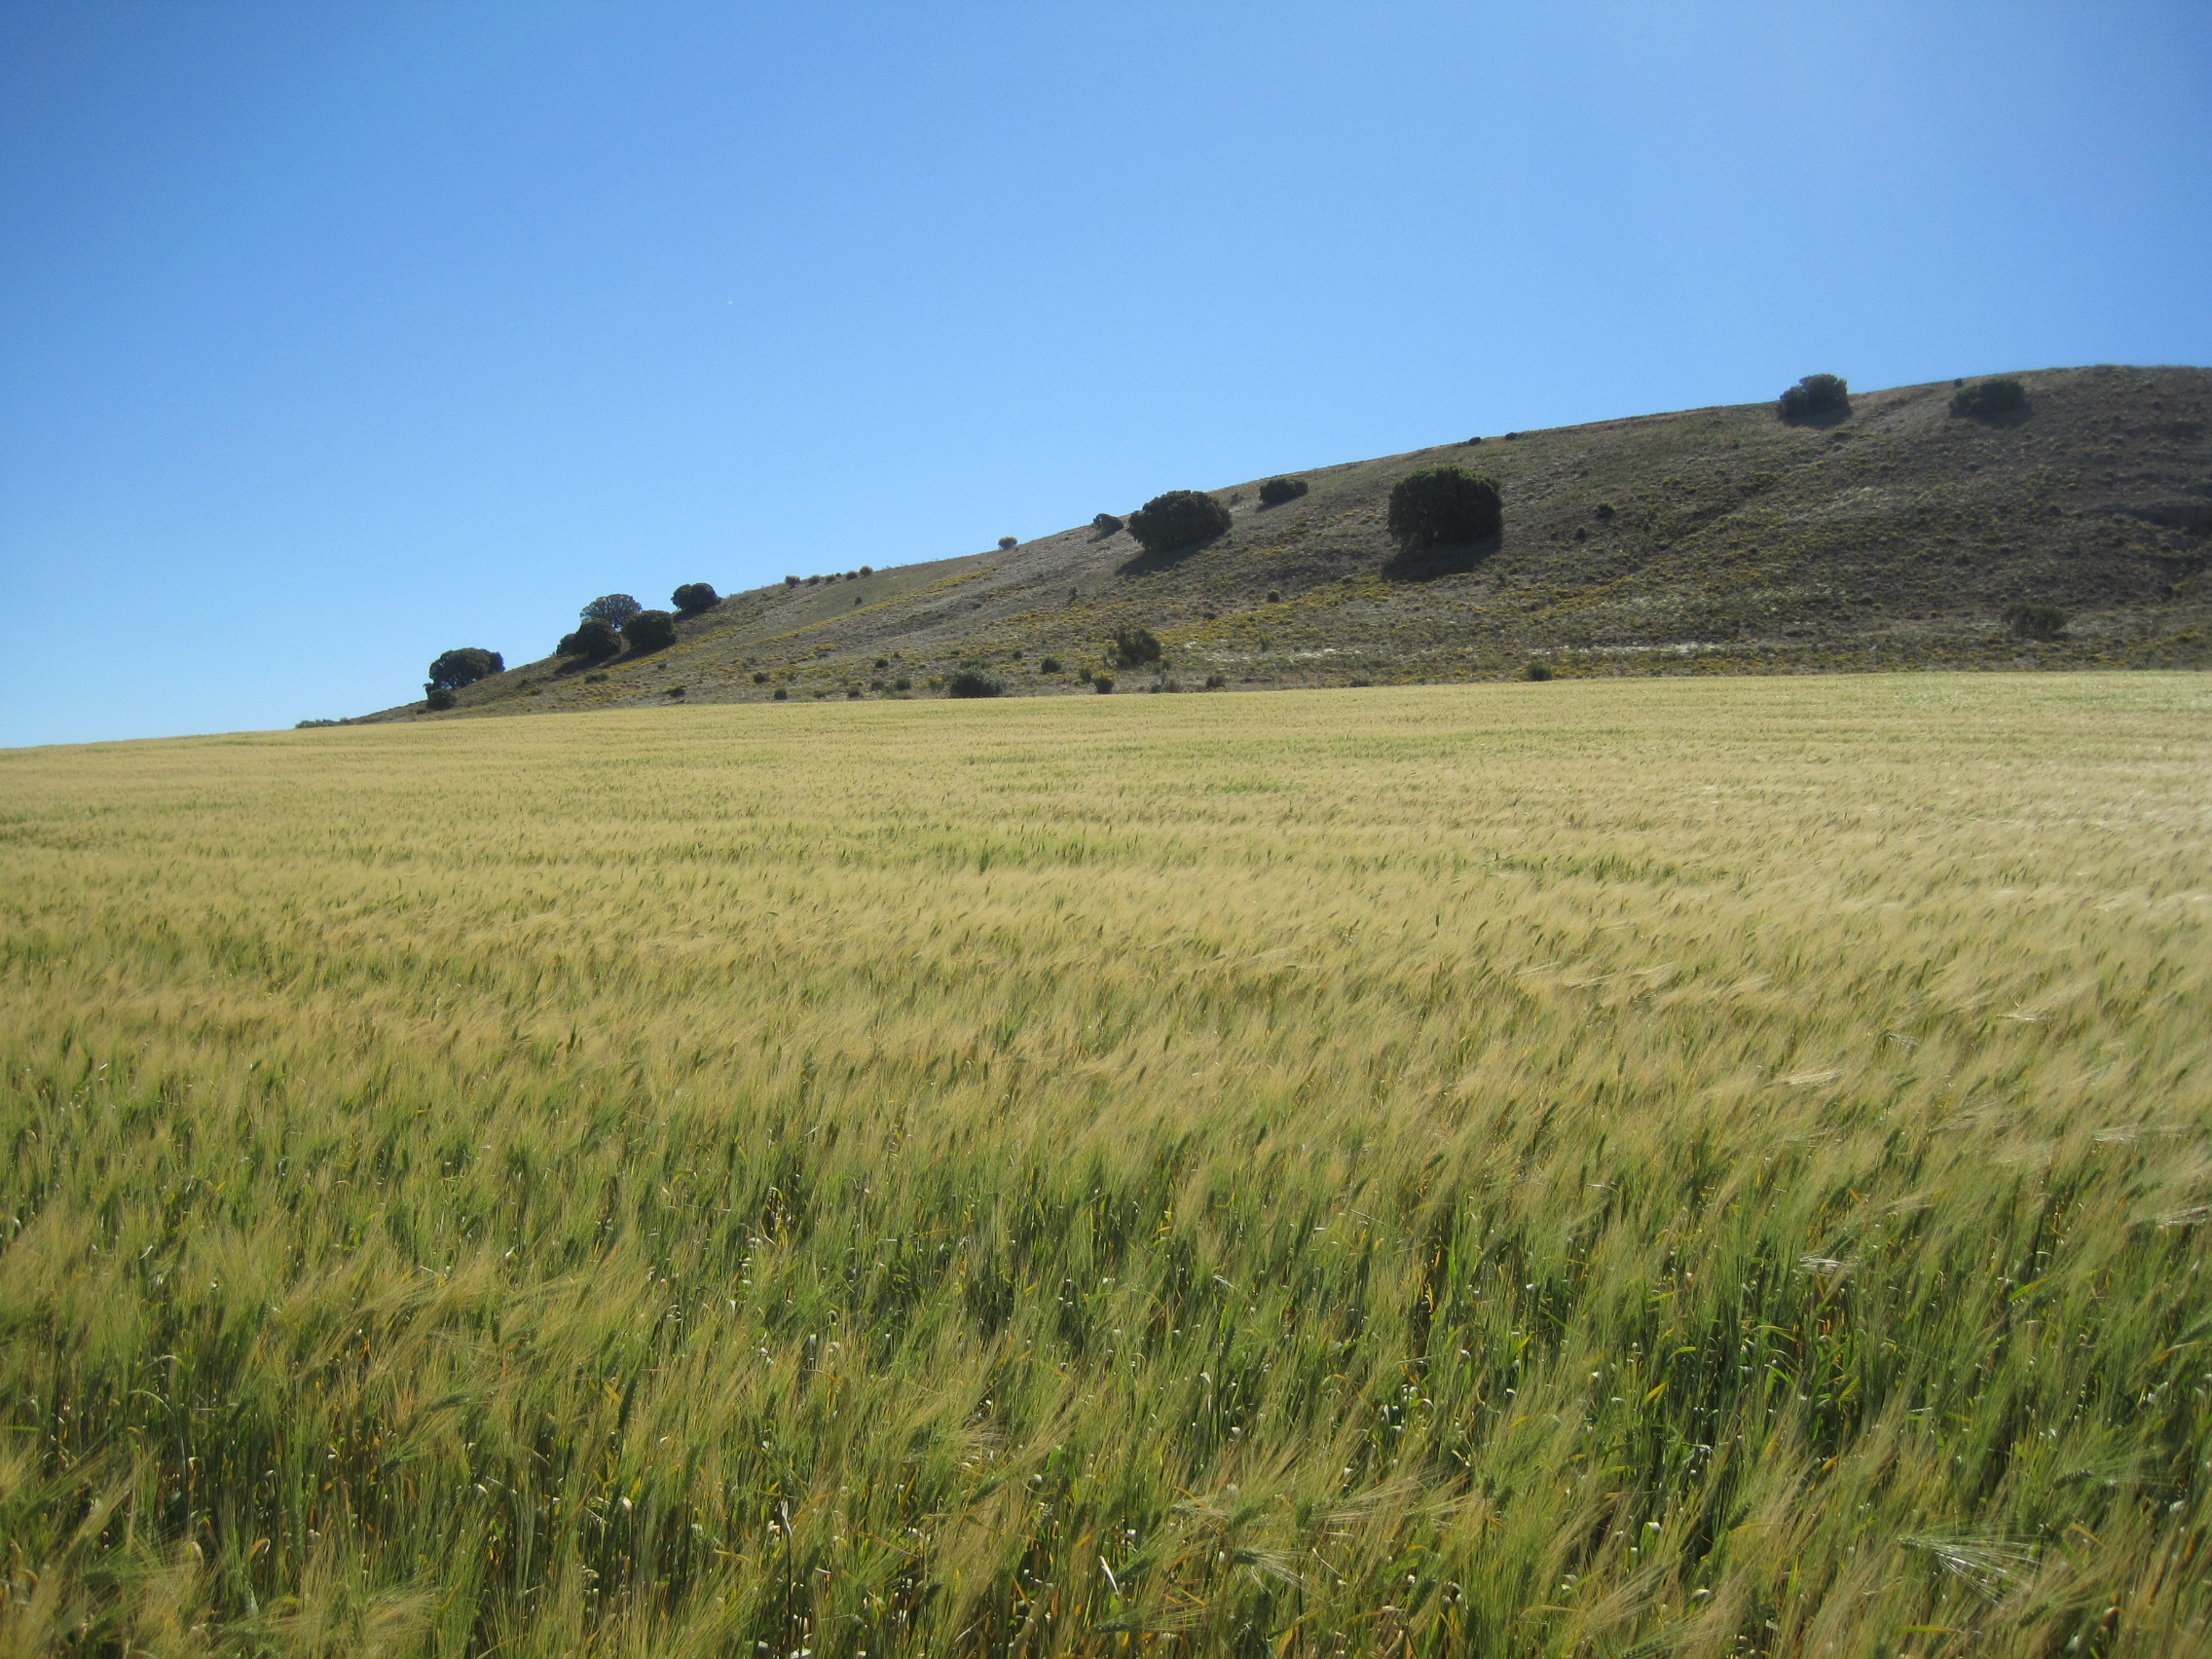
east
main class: Cropland
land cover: Common wheat
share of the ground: > 75 %
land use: Agriculture (excluding fallow land and kitchen gardens)
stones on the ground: < 10 %
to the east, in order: Common wheat; Grassland with sparse tree/shrub cover
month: May
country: ES
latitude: 41.1512
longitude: -5.3134
